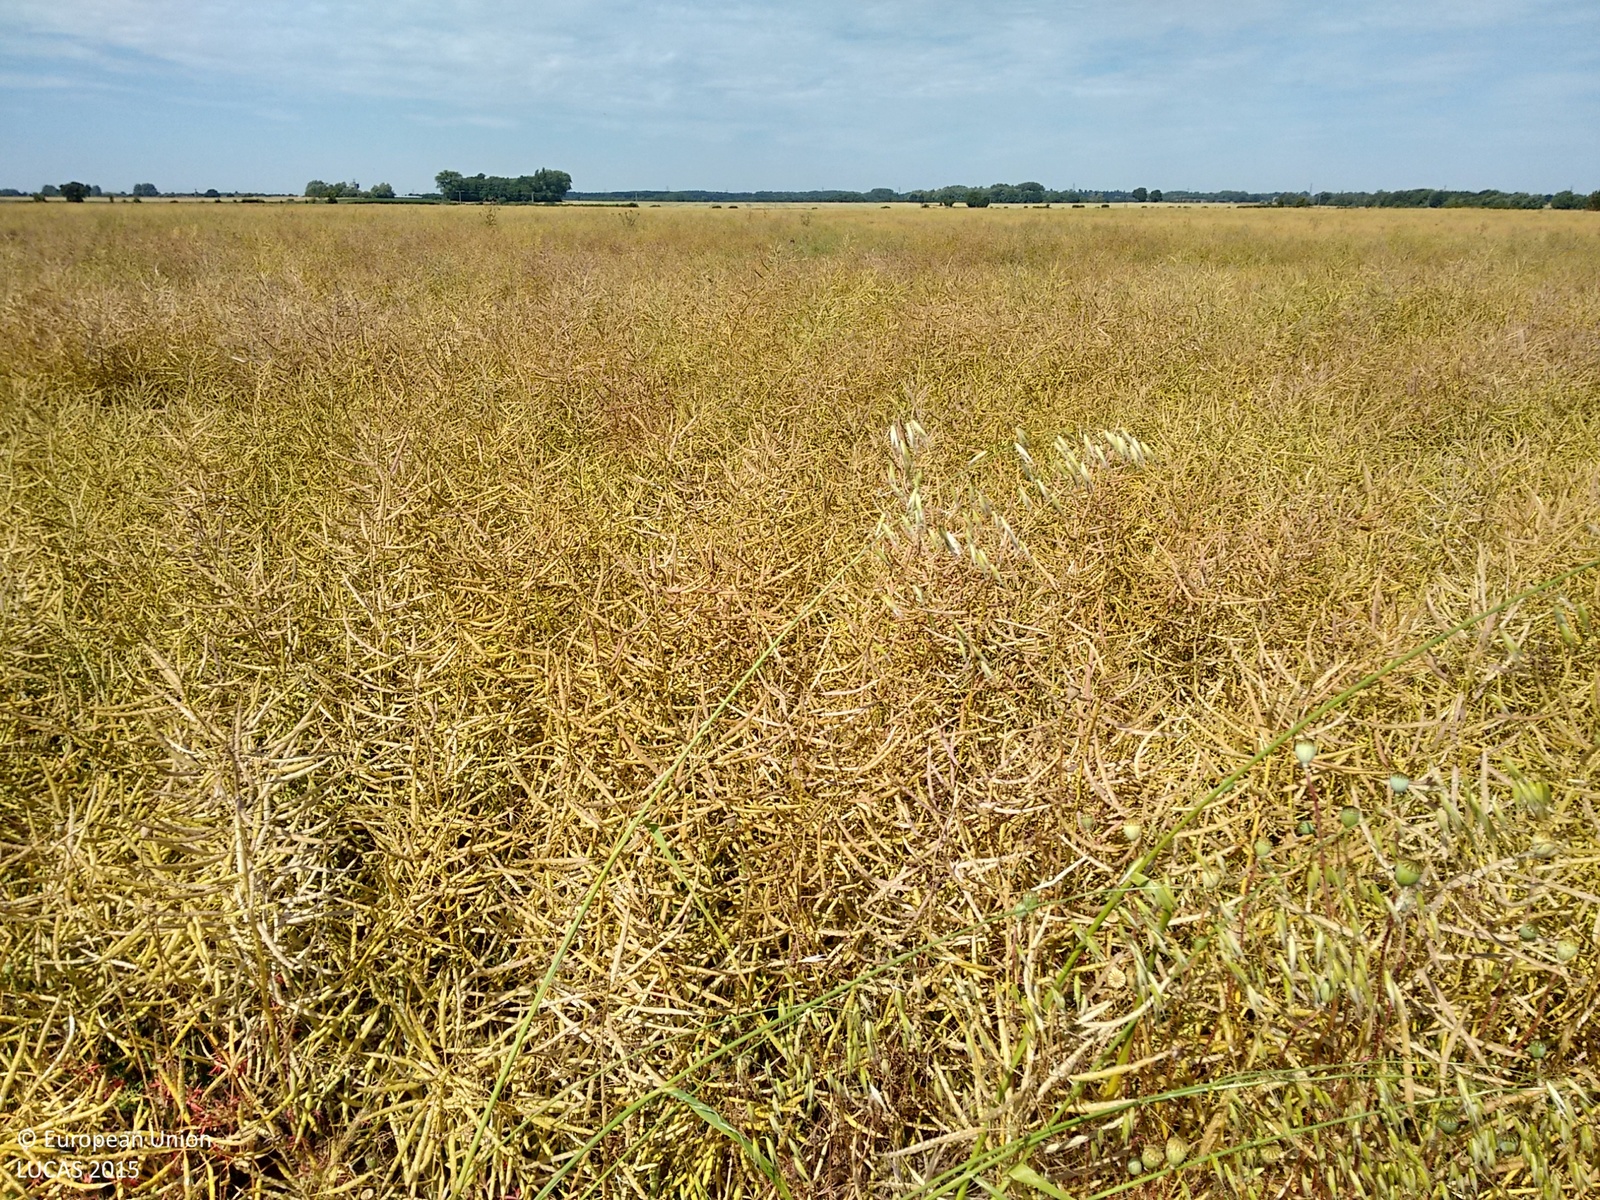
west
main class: Cropland
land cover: Rape and turnip rape
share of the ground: > 75 %
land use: Agriculture (excluding fallow land and kitchen gardens)
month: July
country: GB
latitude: 51.6701
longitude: -1.1367
